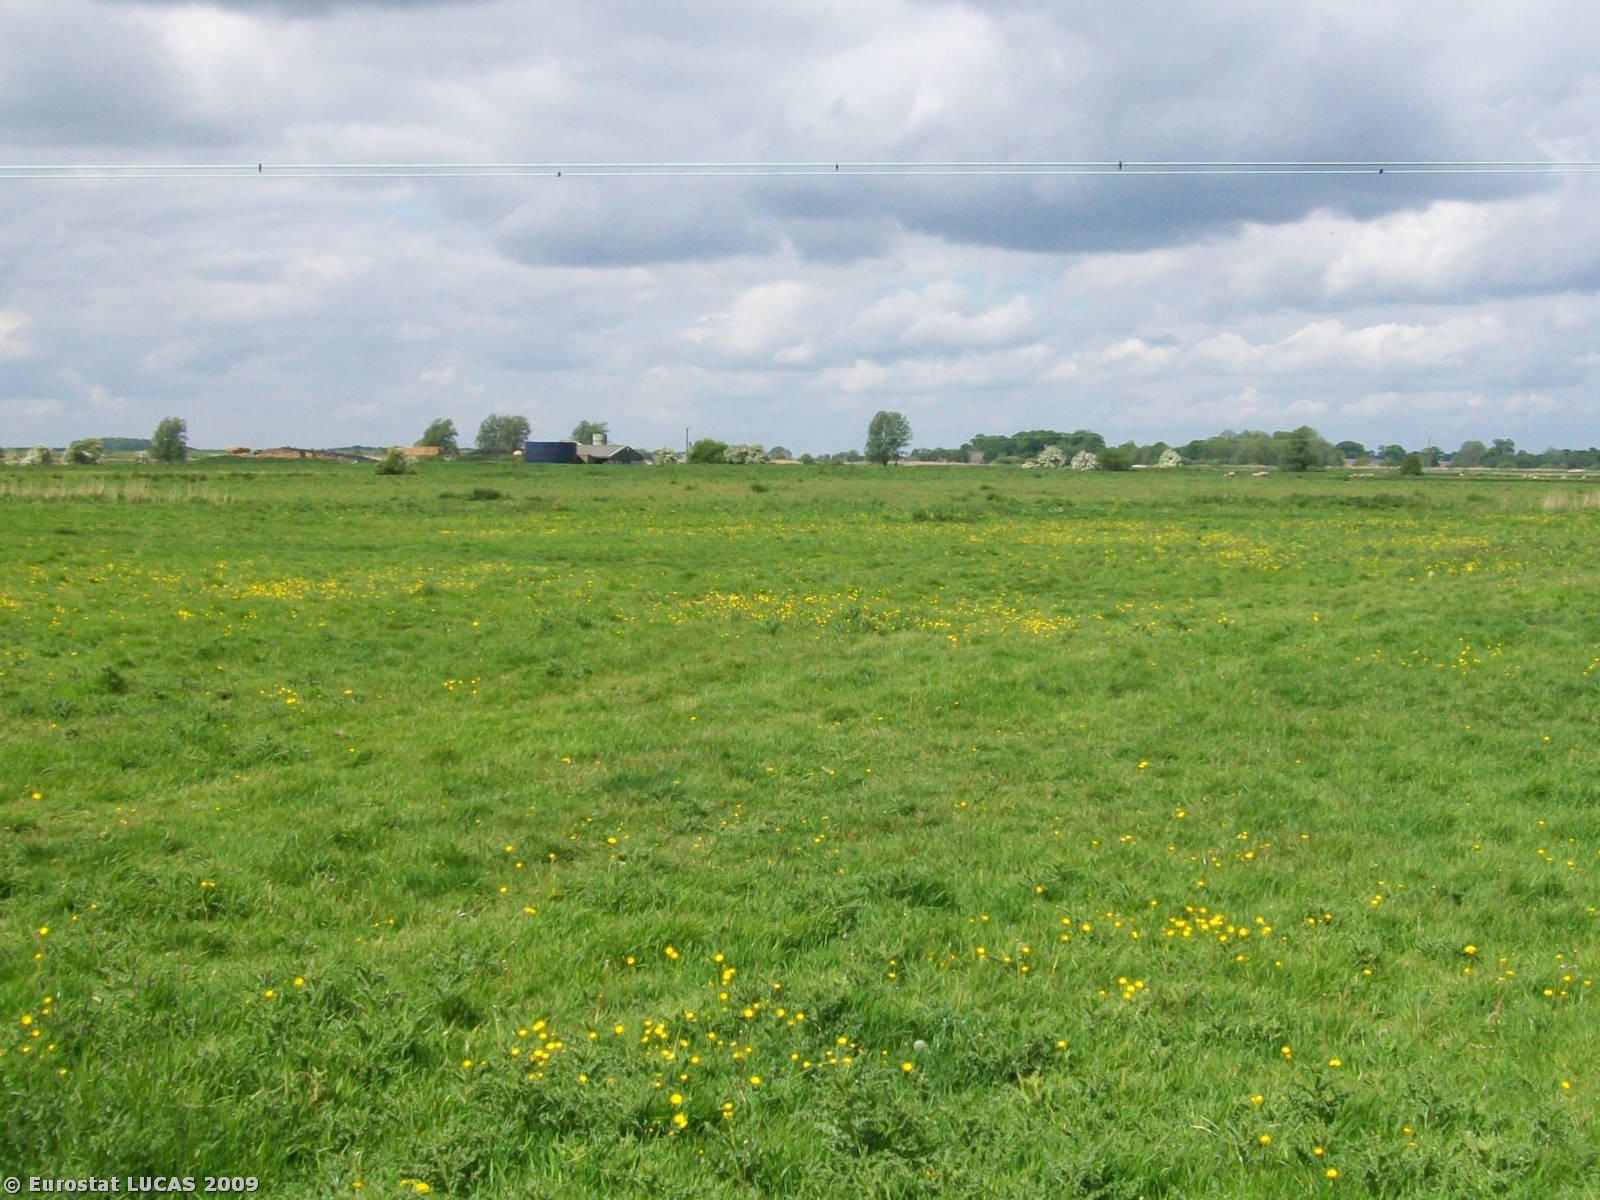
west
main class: Grassland
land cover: Grassland without tree/shrub cover
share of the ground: > 75 %
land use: Agriculture (excluding fallow land and kitchen gardens)
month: May
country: GB
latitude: 52.6893
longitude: 1.5336
